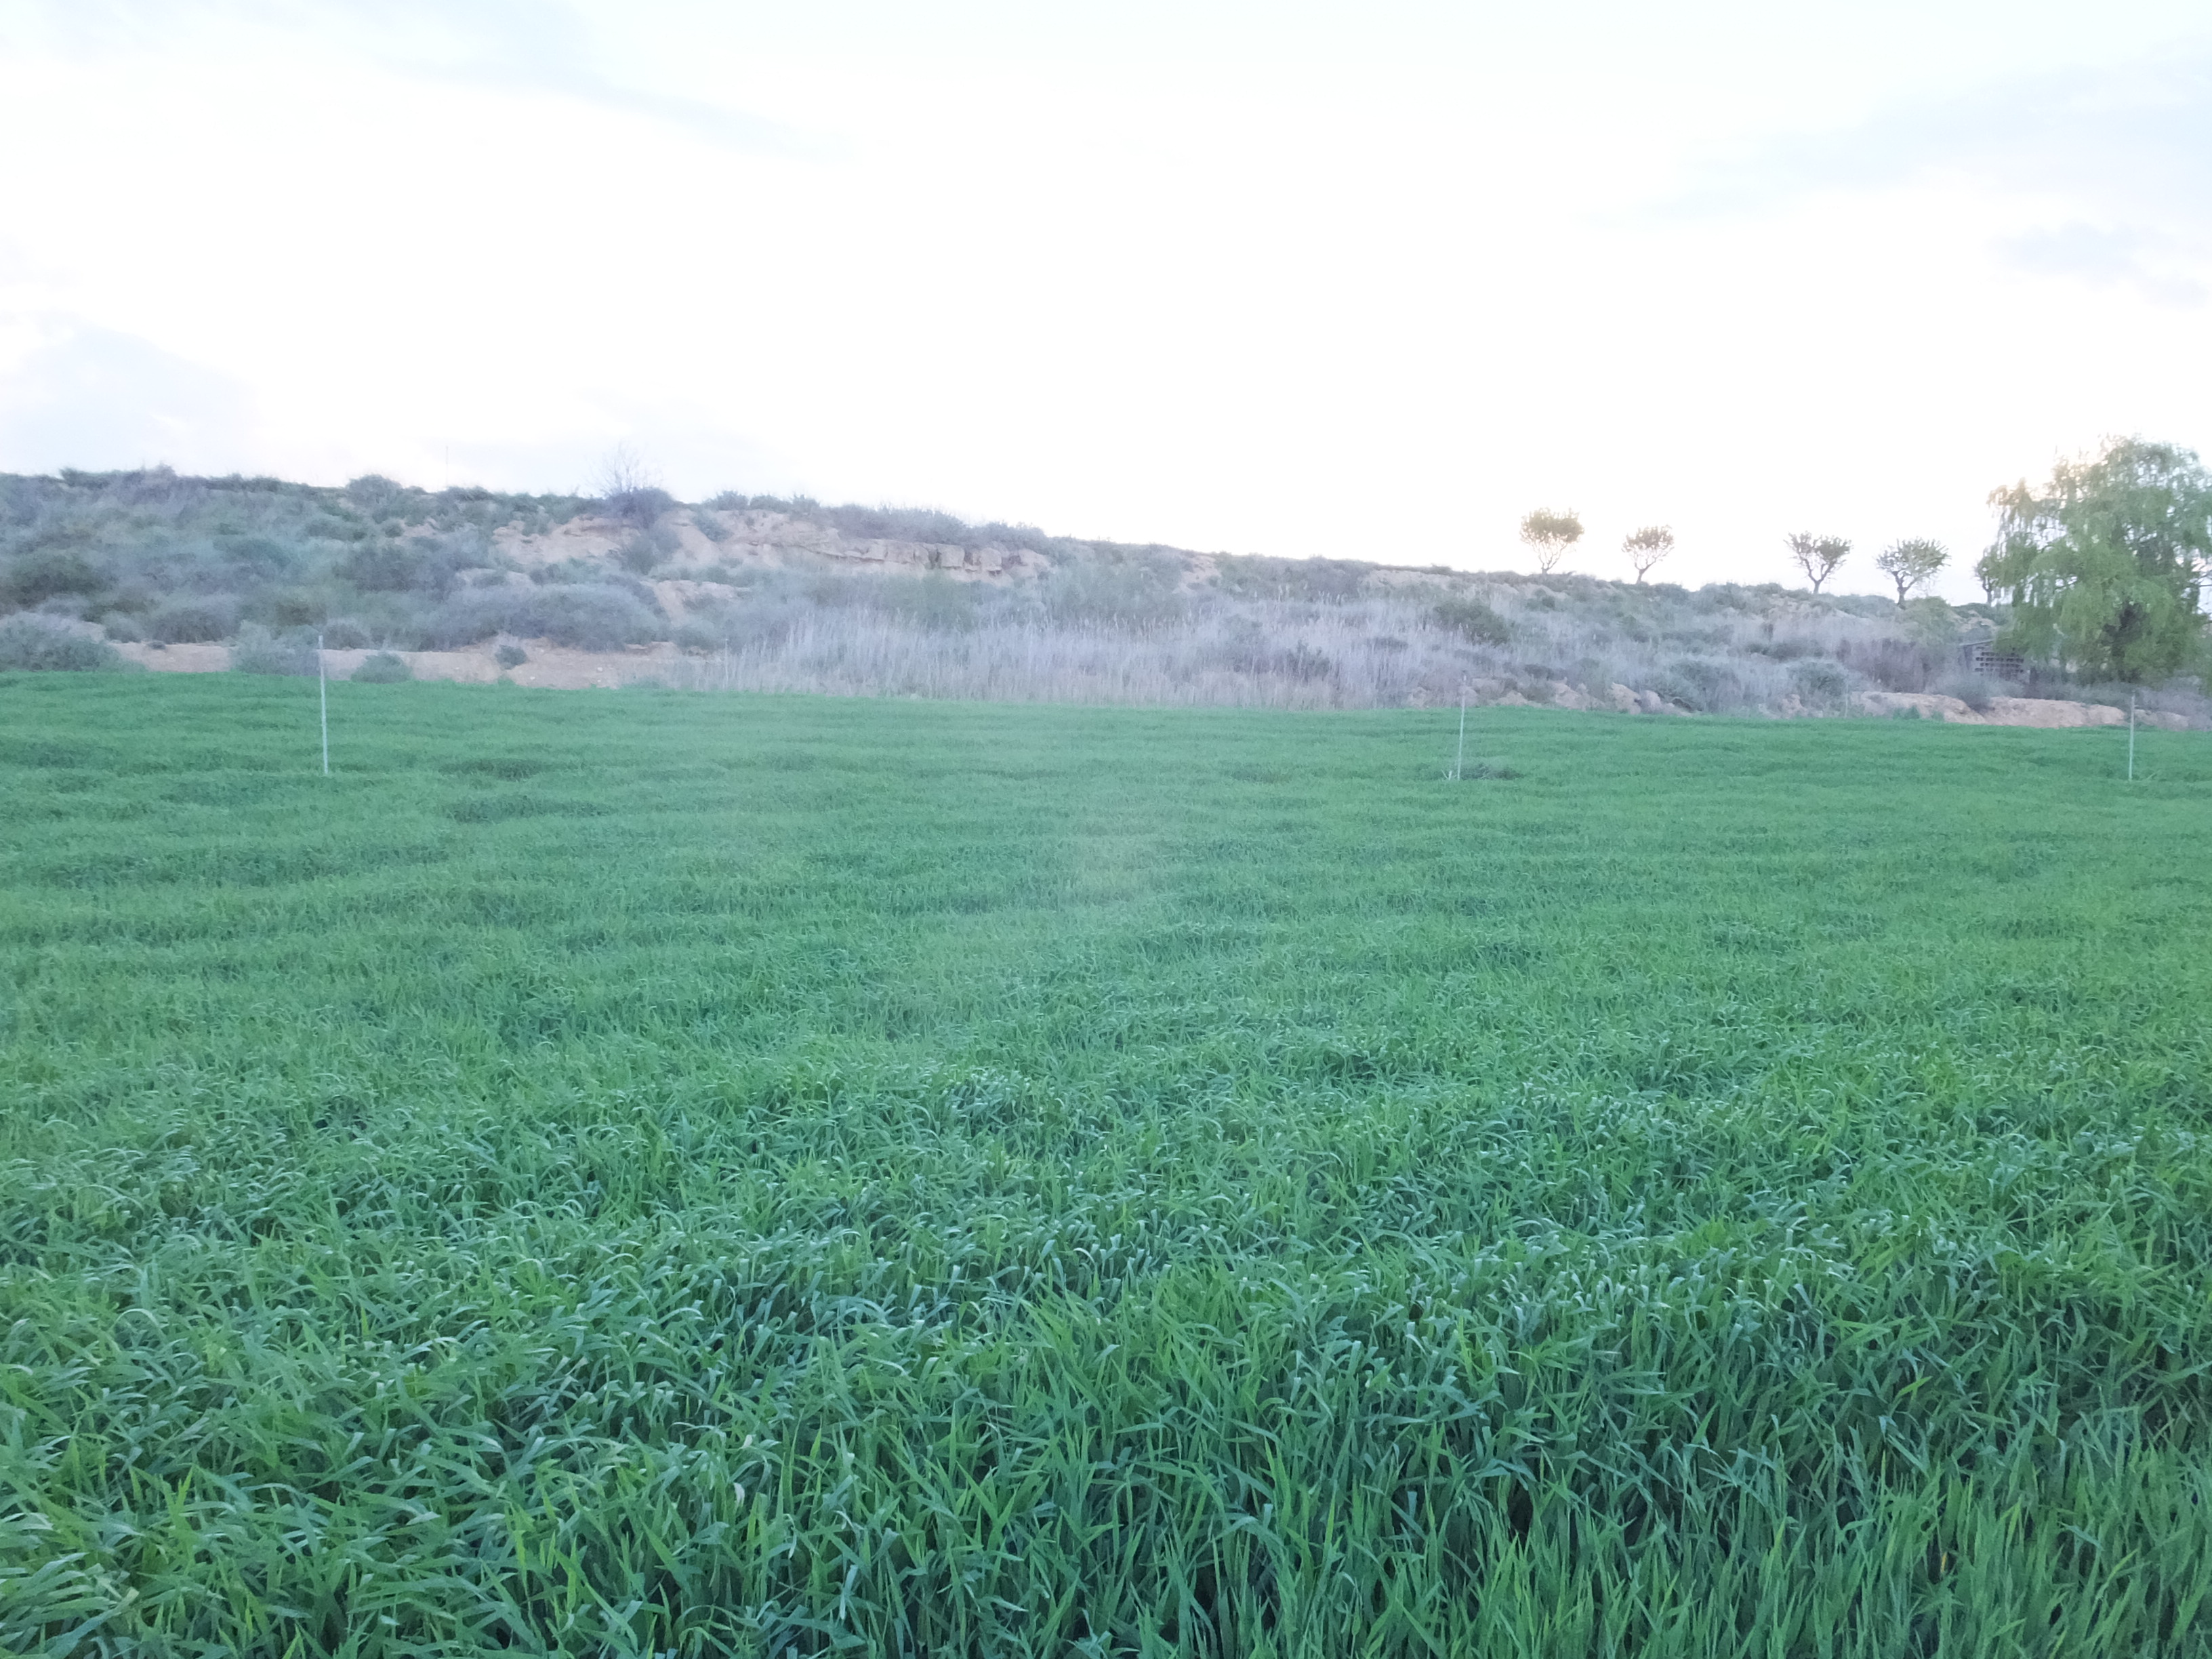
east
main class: Shrubland
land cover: Shrubland without tree cover
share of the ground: 50 - 75 %
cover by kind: shrubs 55 %, herbaceous plants 45 %
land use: Semi-natural and natural areas not in use
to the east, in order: Shrubland without tree cover; Common wheat; Grass margins; Rock outcrops; Shrubland without tree cover; Ditches and canals; Shrubland without tree cover; Abandoned hedges; Grass margins; Common wheat
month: April
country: ES
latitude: 41.7861
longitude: -0.2583
